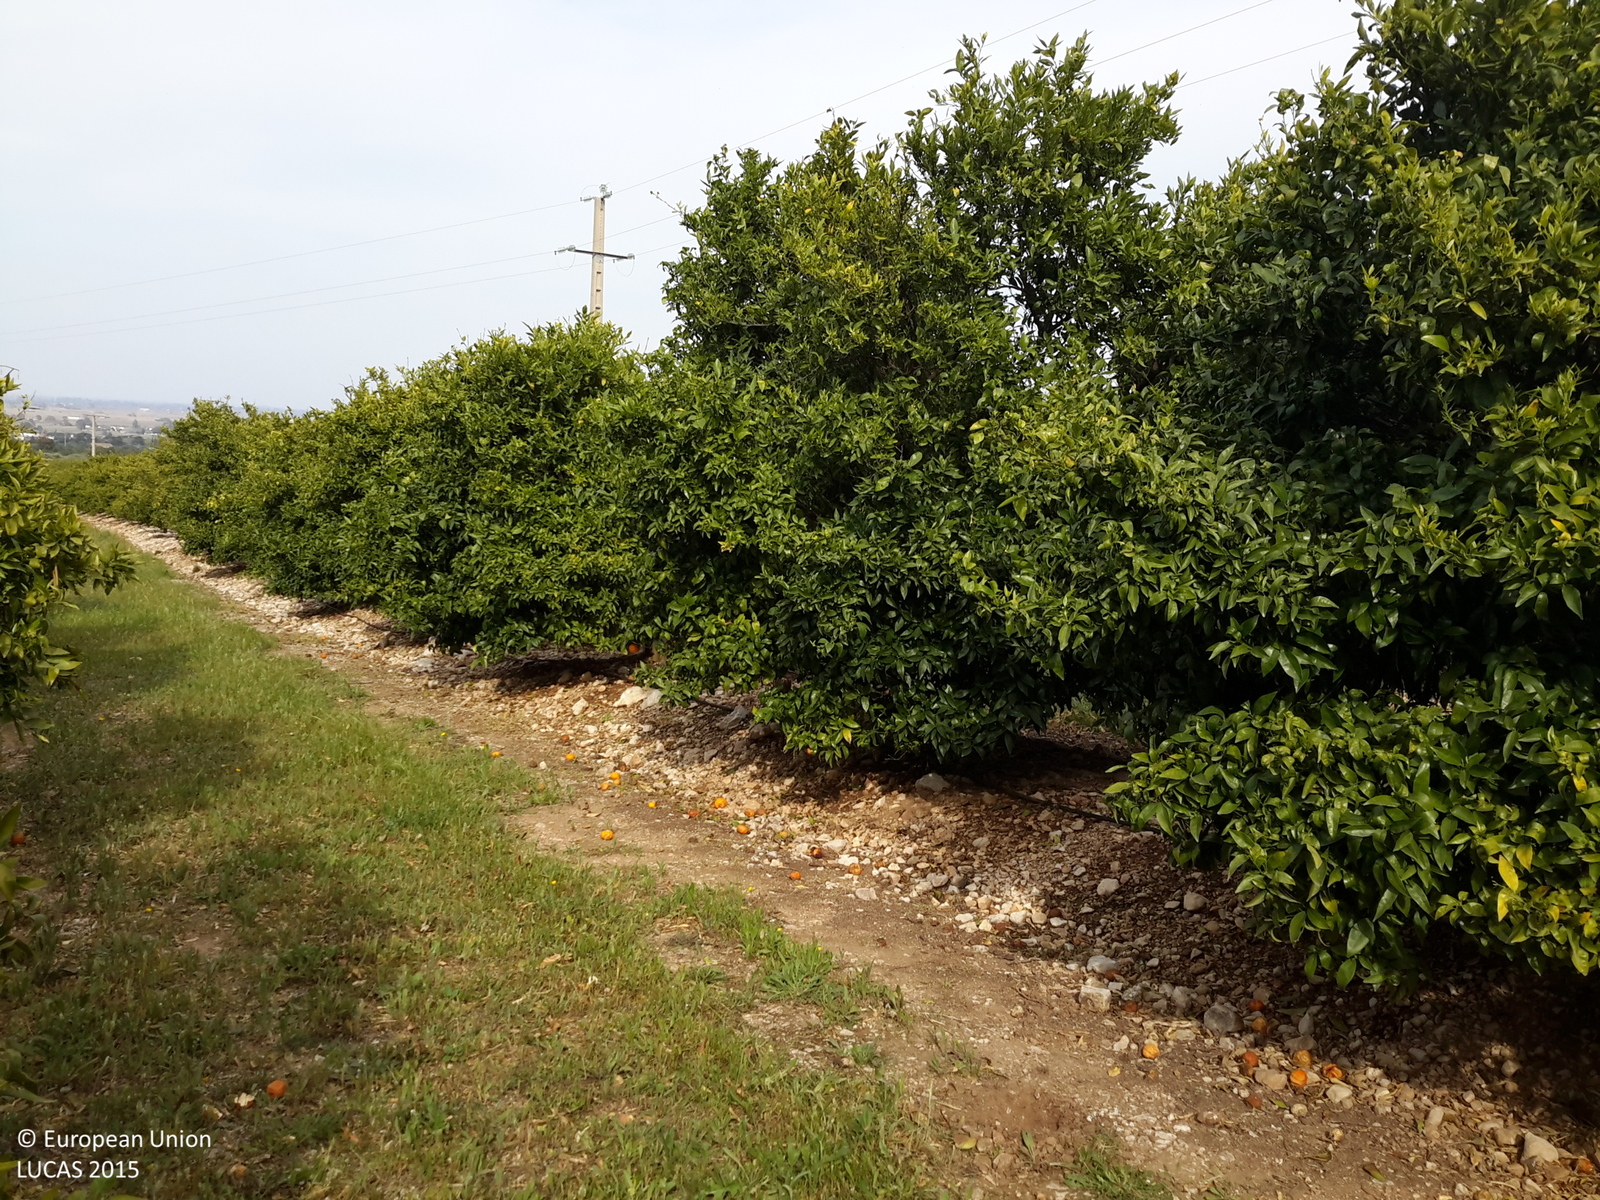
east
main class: Cropland
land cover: Oranges
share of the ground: 25 - 50 %
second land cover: Spontaneously vegetated surfaces
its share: 50 - 75 %
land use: Agriculture (excluding fallow land and kitchen gardens)
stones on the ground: > 50 %
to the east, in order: Oranges; Spontaneously vegetated surfaces; Shrubland with sparse tree cover; Electric lines; Shrubland with sparse tree cover; Tracks; Shrubland with sparse tree cover; Electric lines; Broadleaved woodland; Olive groves; Dry stone walls; Olive groves; Dry stone walls; Olive groves; Dry stone walls; Olive groves
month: April
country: ES
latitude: 40.6674
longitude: 0.5674
